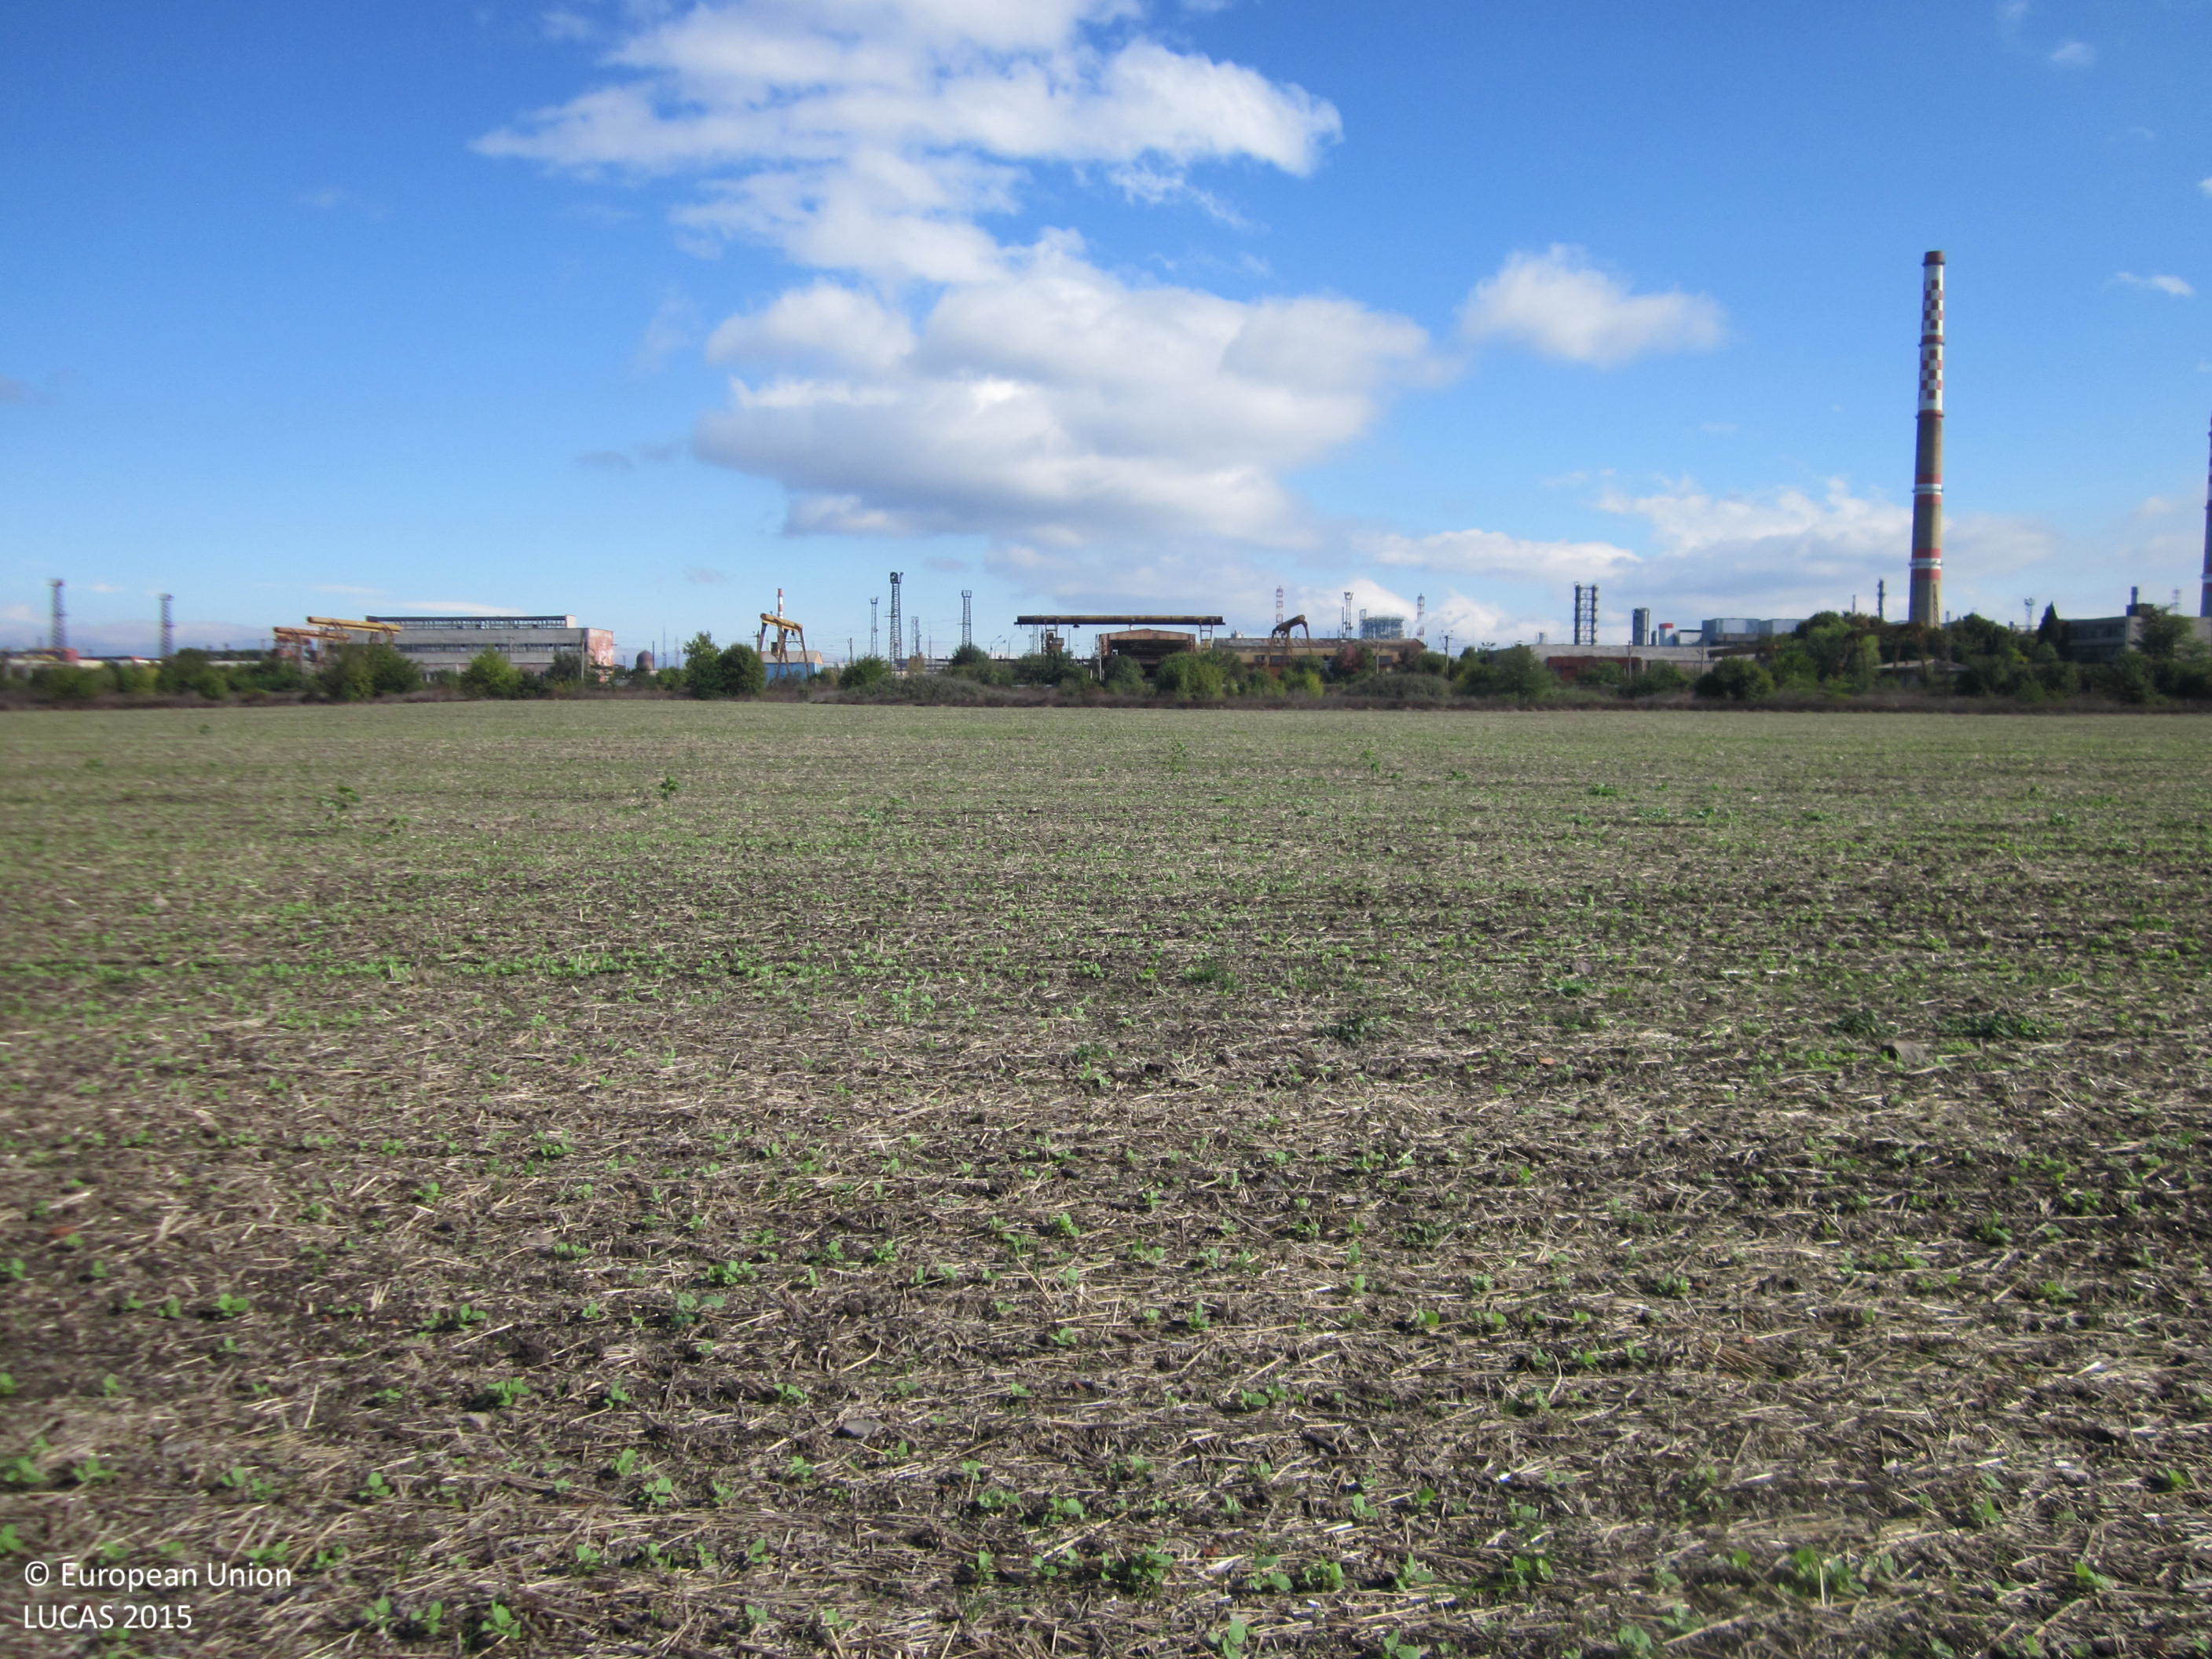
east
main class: Cropland
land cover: Common wheat
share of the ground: 10 - 25 %
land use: Agriculture (excluding fallow land and kitchen gardens)
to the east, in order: Common wheat; Grass margins
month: October
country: BG
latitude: 42.5487
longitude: 27.3211
